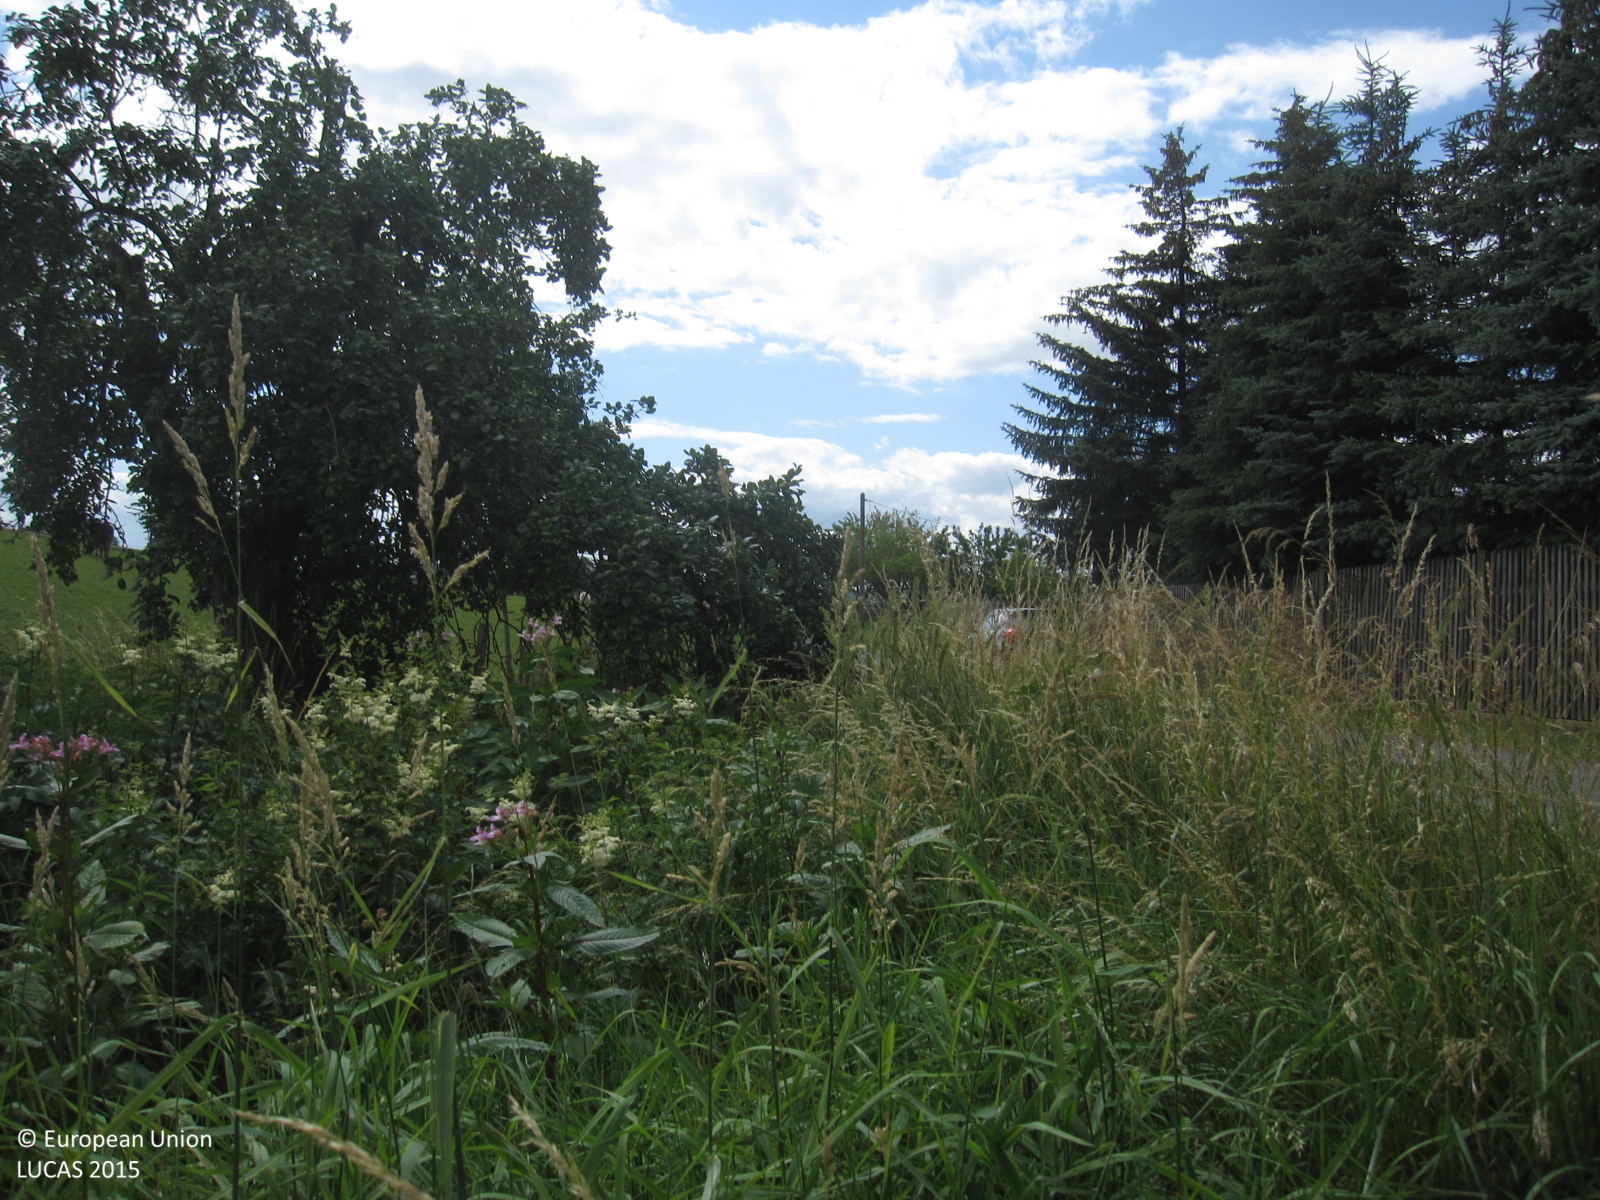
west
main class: Cropland
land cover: Cherry fruit
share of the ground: 50 - 75 %
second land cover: Grassland without tree/shrub cover
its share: > 75 %
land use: Agriculture (excluding fallow land and kitchen gardens)
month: July
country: DE
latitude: 50.9580
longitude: 12.0070
